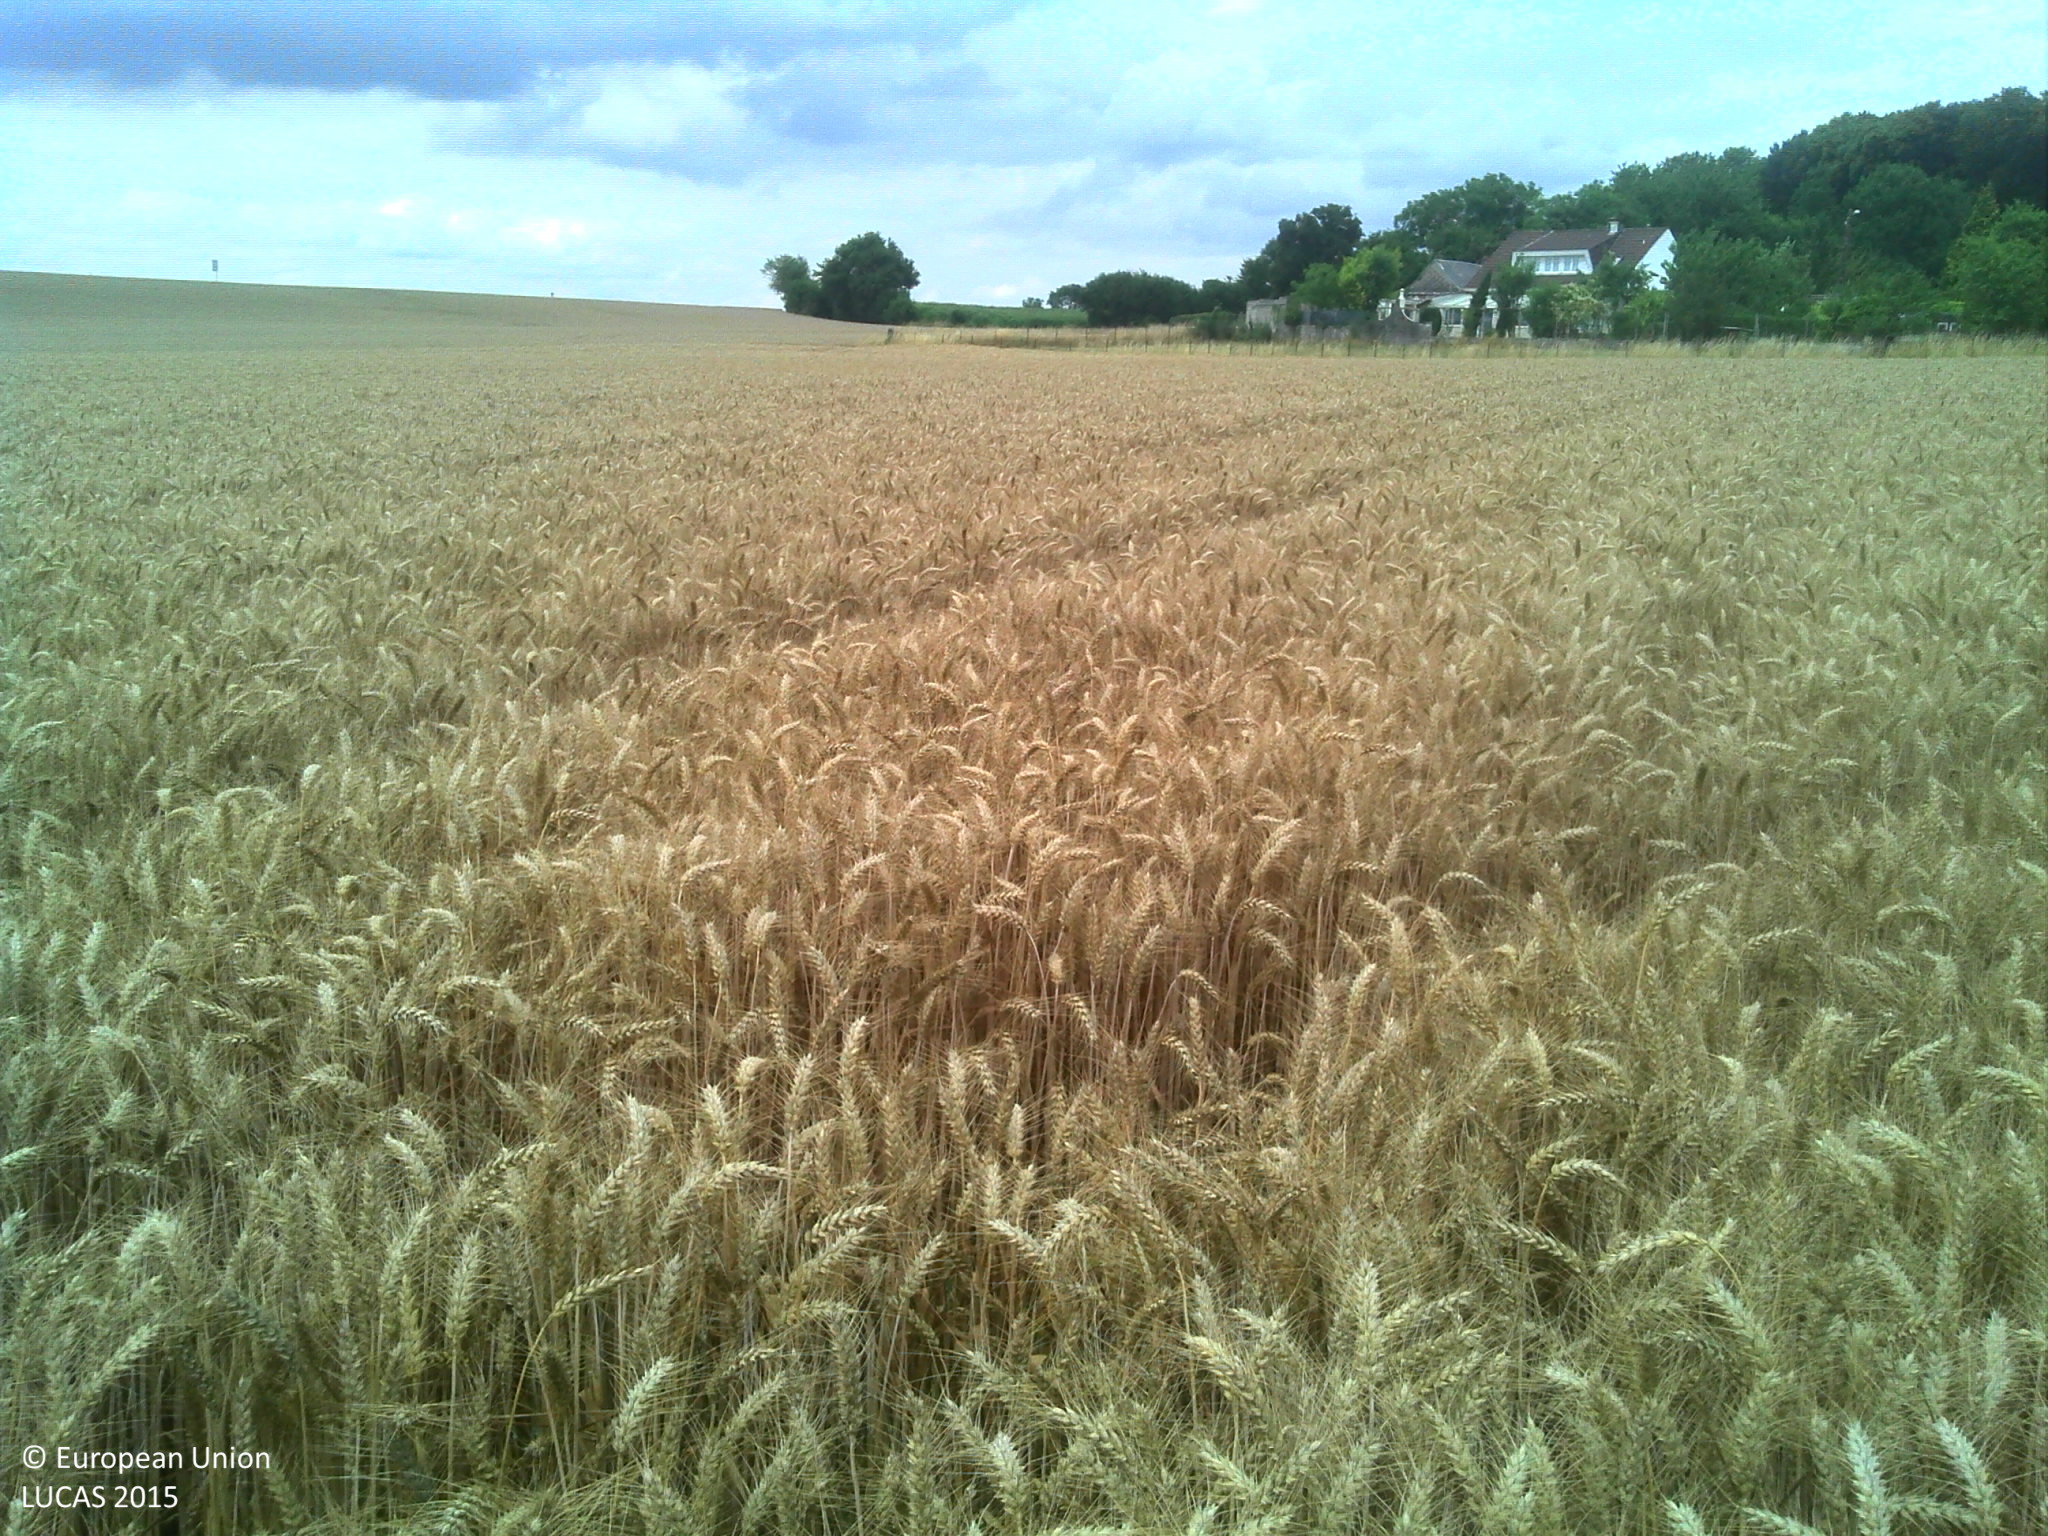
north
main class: Cropland
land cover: Common wheat
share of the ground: > 75 %
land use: Agriculture (excluding fallow land and kitchen gardens)
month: July
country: FR
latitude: 49.8263
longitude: 3.6404
